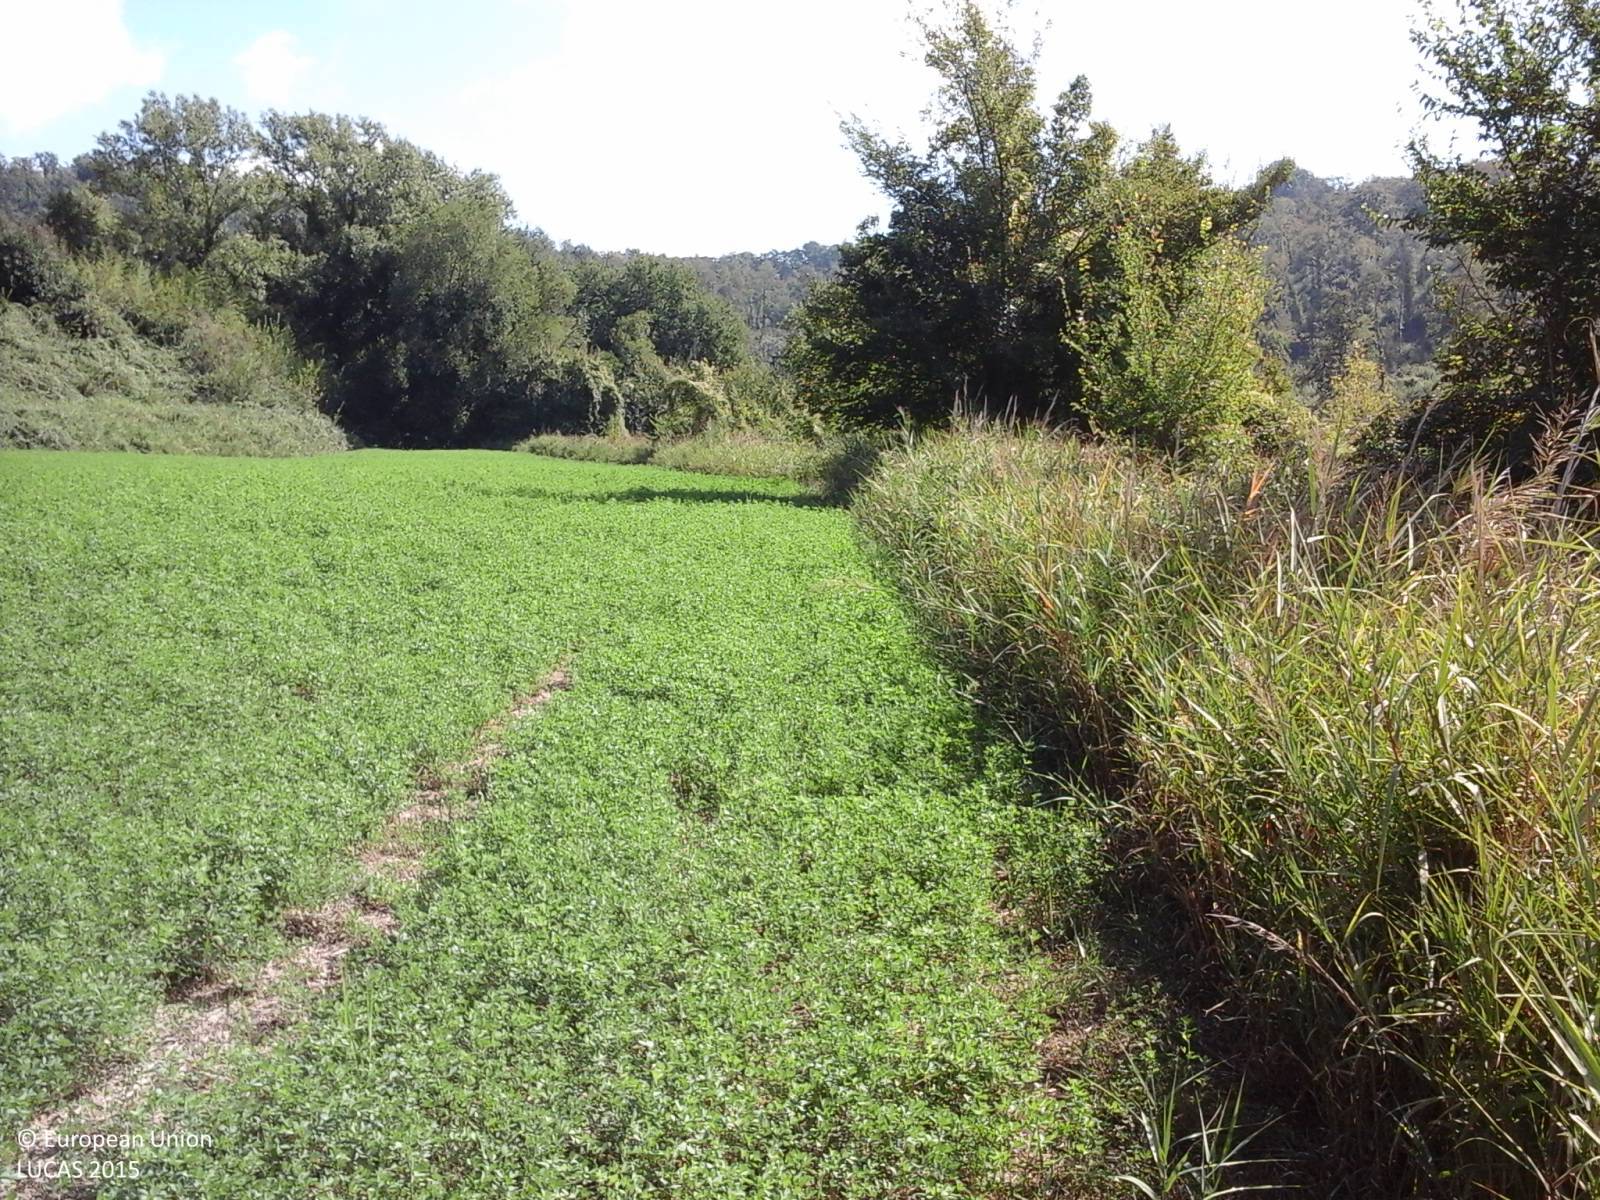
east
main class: Shrubland
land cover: Shrubland without tree cover
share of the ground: > 75 %
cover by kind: shrubs 100 %
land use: Agriculture (excluding fallow land and kitchen gardens)
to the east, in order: Shrubland without tree cover; Broadleaved woodland; Rivers and streams; Broadleaved woodland; Grassland without tree/shrub cover; Broadleaved woodland
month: September
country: IT
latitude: 42.2960
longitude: 12.5747
